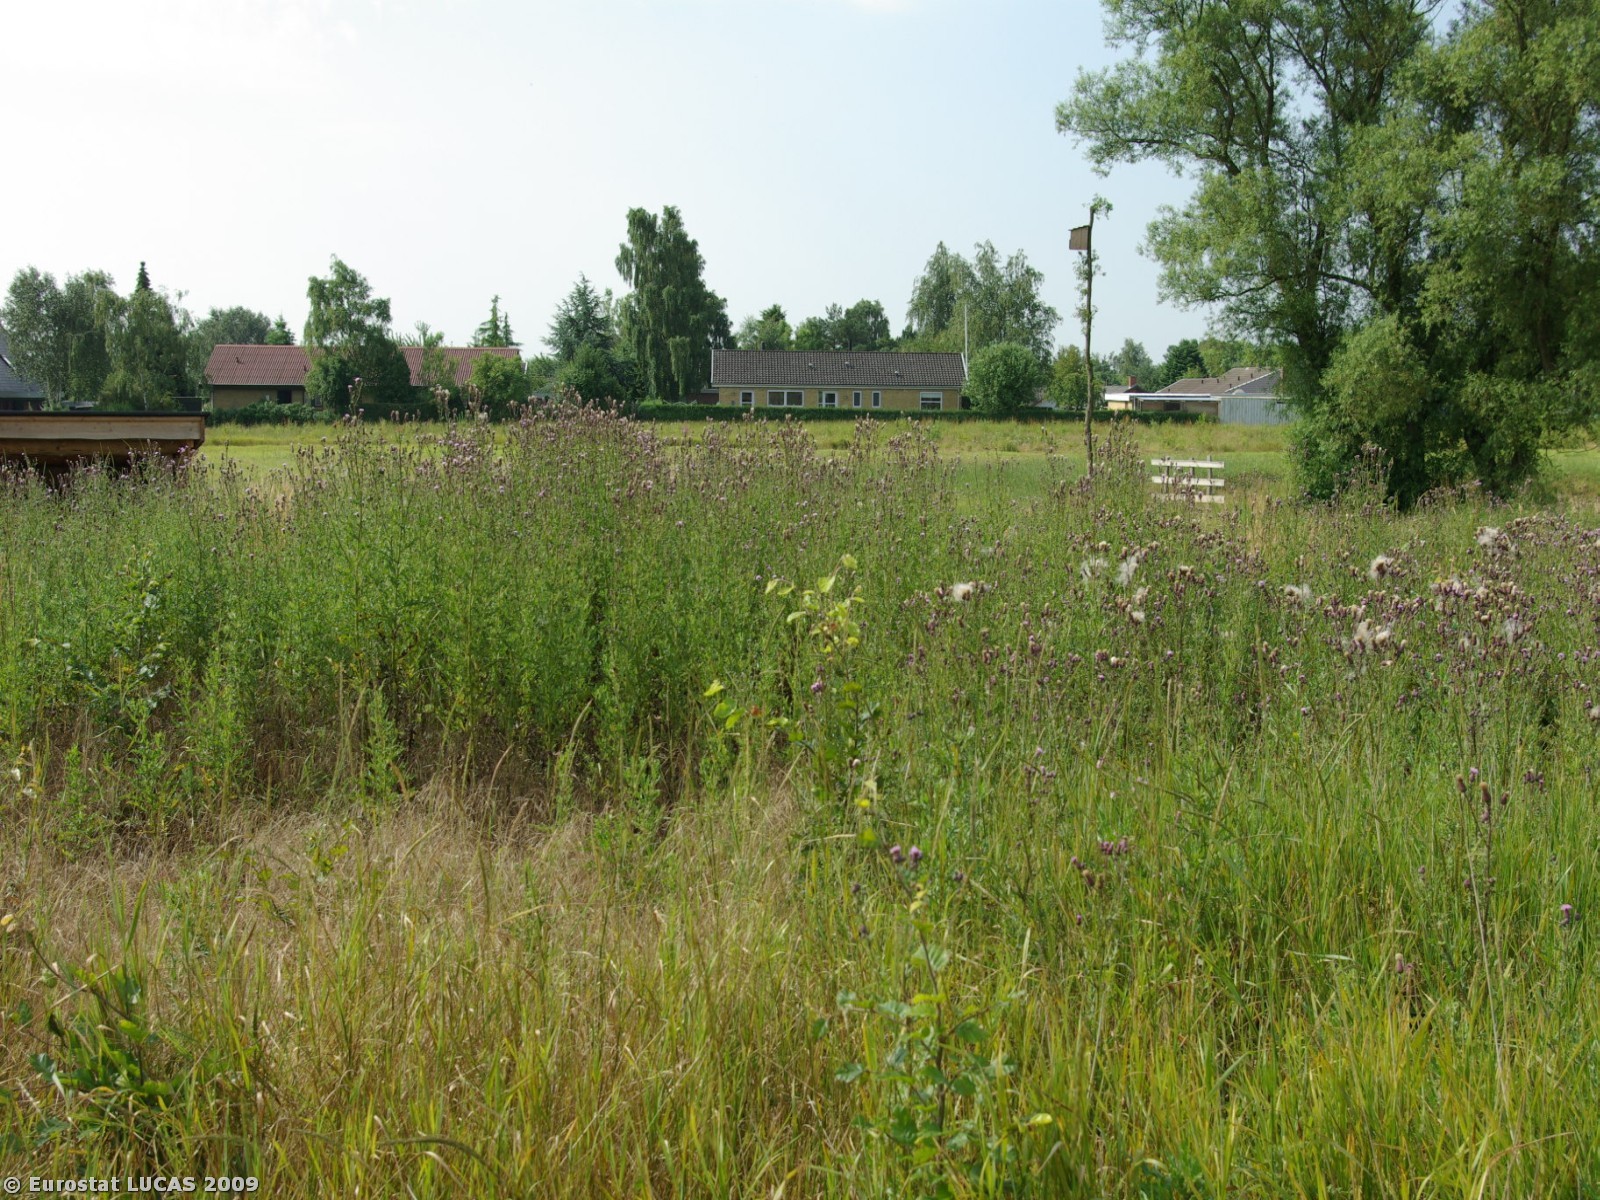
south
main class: Woodland
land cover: Broadleaved woodland
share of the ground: < 10 %
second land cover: Spontaneously vegetated surfaces
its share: > 75 %
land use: Amenities, museums, leisure
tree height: < 5 m
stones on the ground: < 10 %
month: July
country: DK
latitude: 54.9291
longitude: 9.6725
